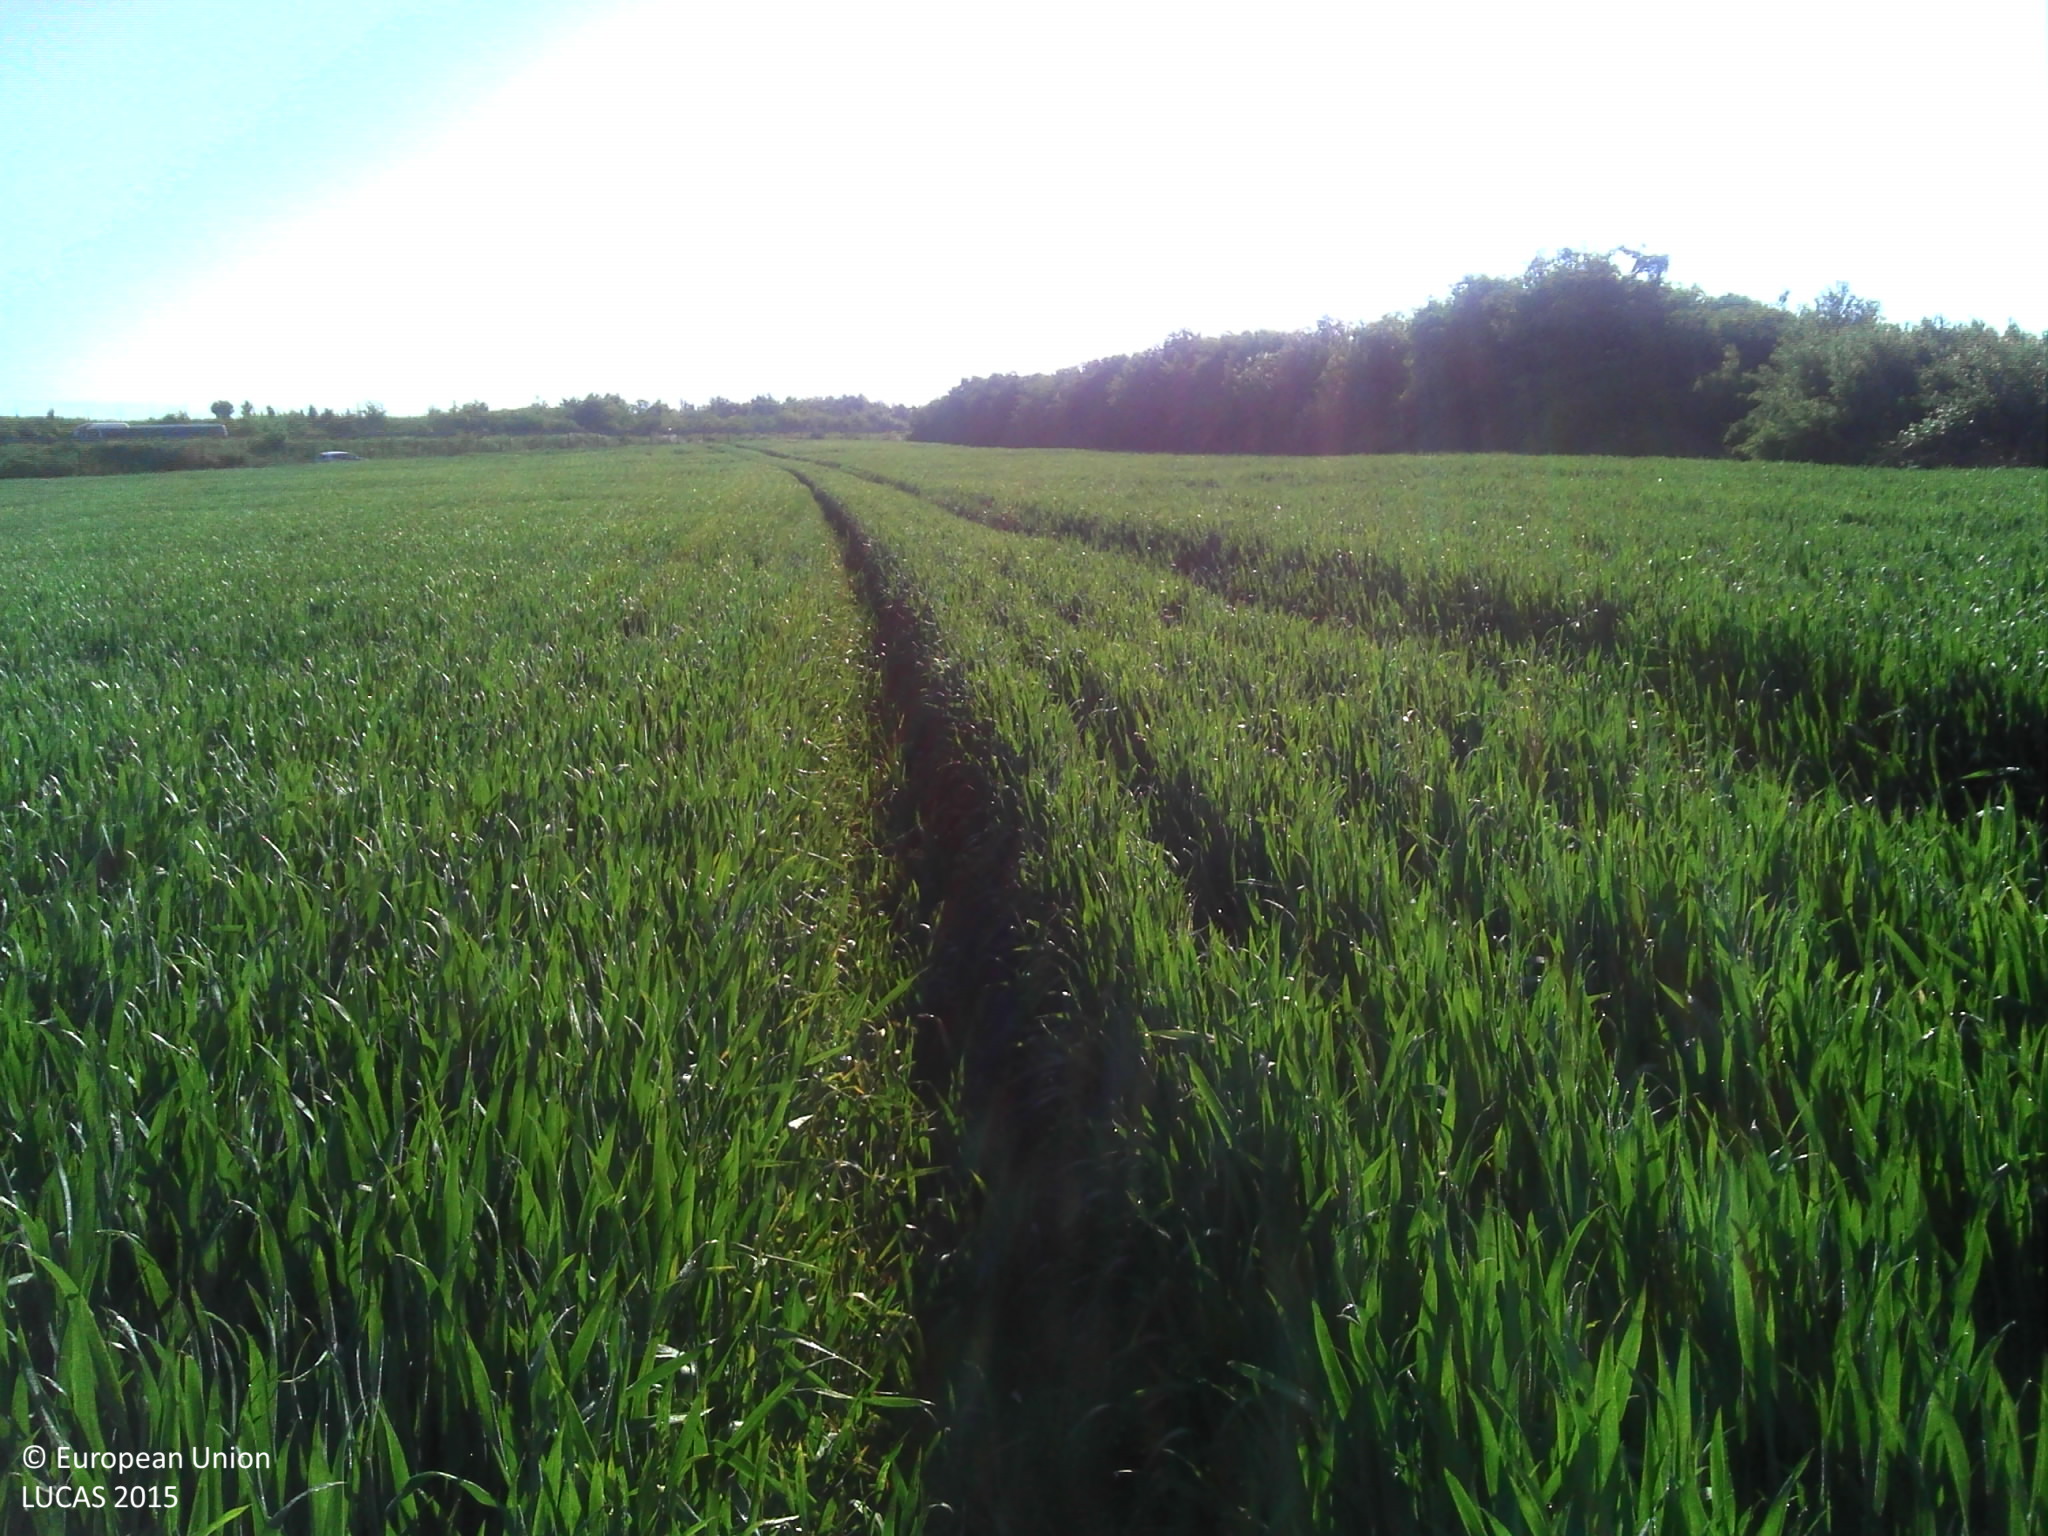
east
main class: Cropland
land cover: Common wheat
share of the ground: > 75 %
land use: Agriculture (excluding fallow land and kitchen gardens)
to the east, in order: Common wheat; Broadleaved woodland; Common wheat
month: May
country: LU
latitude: 49.4946
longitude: 6.3134
